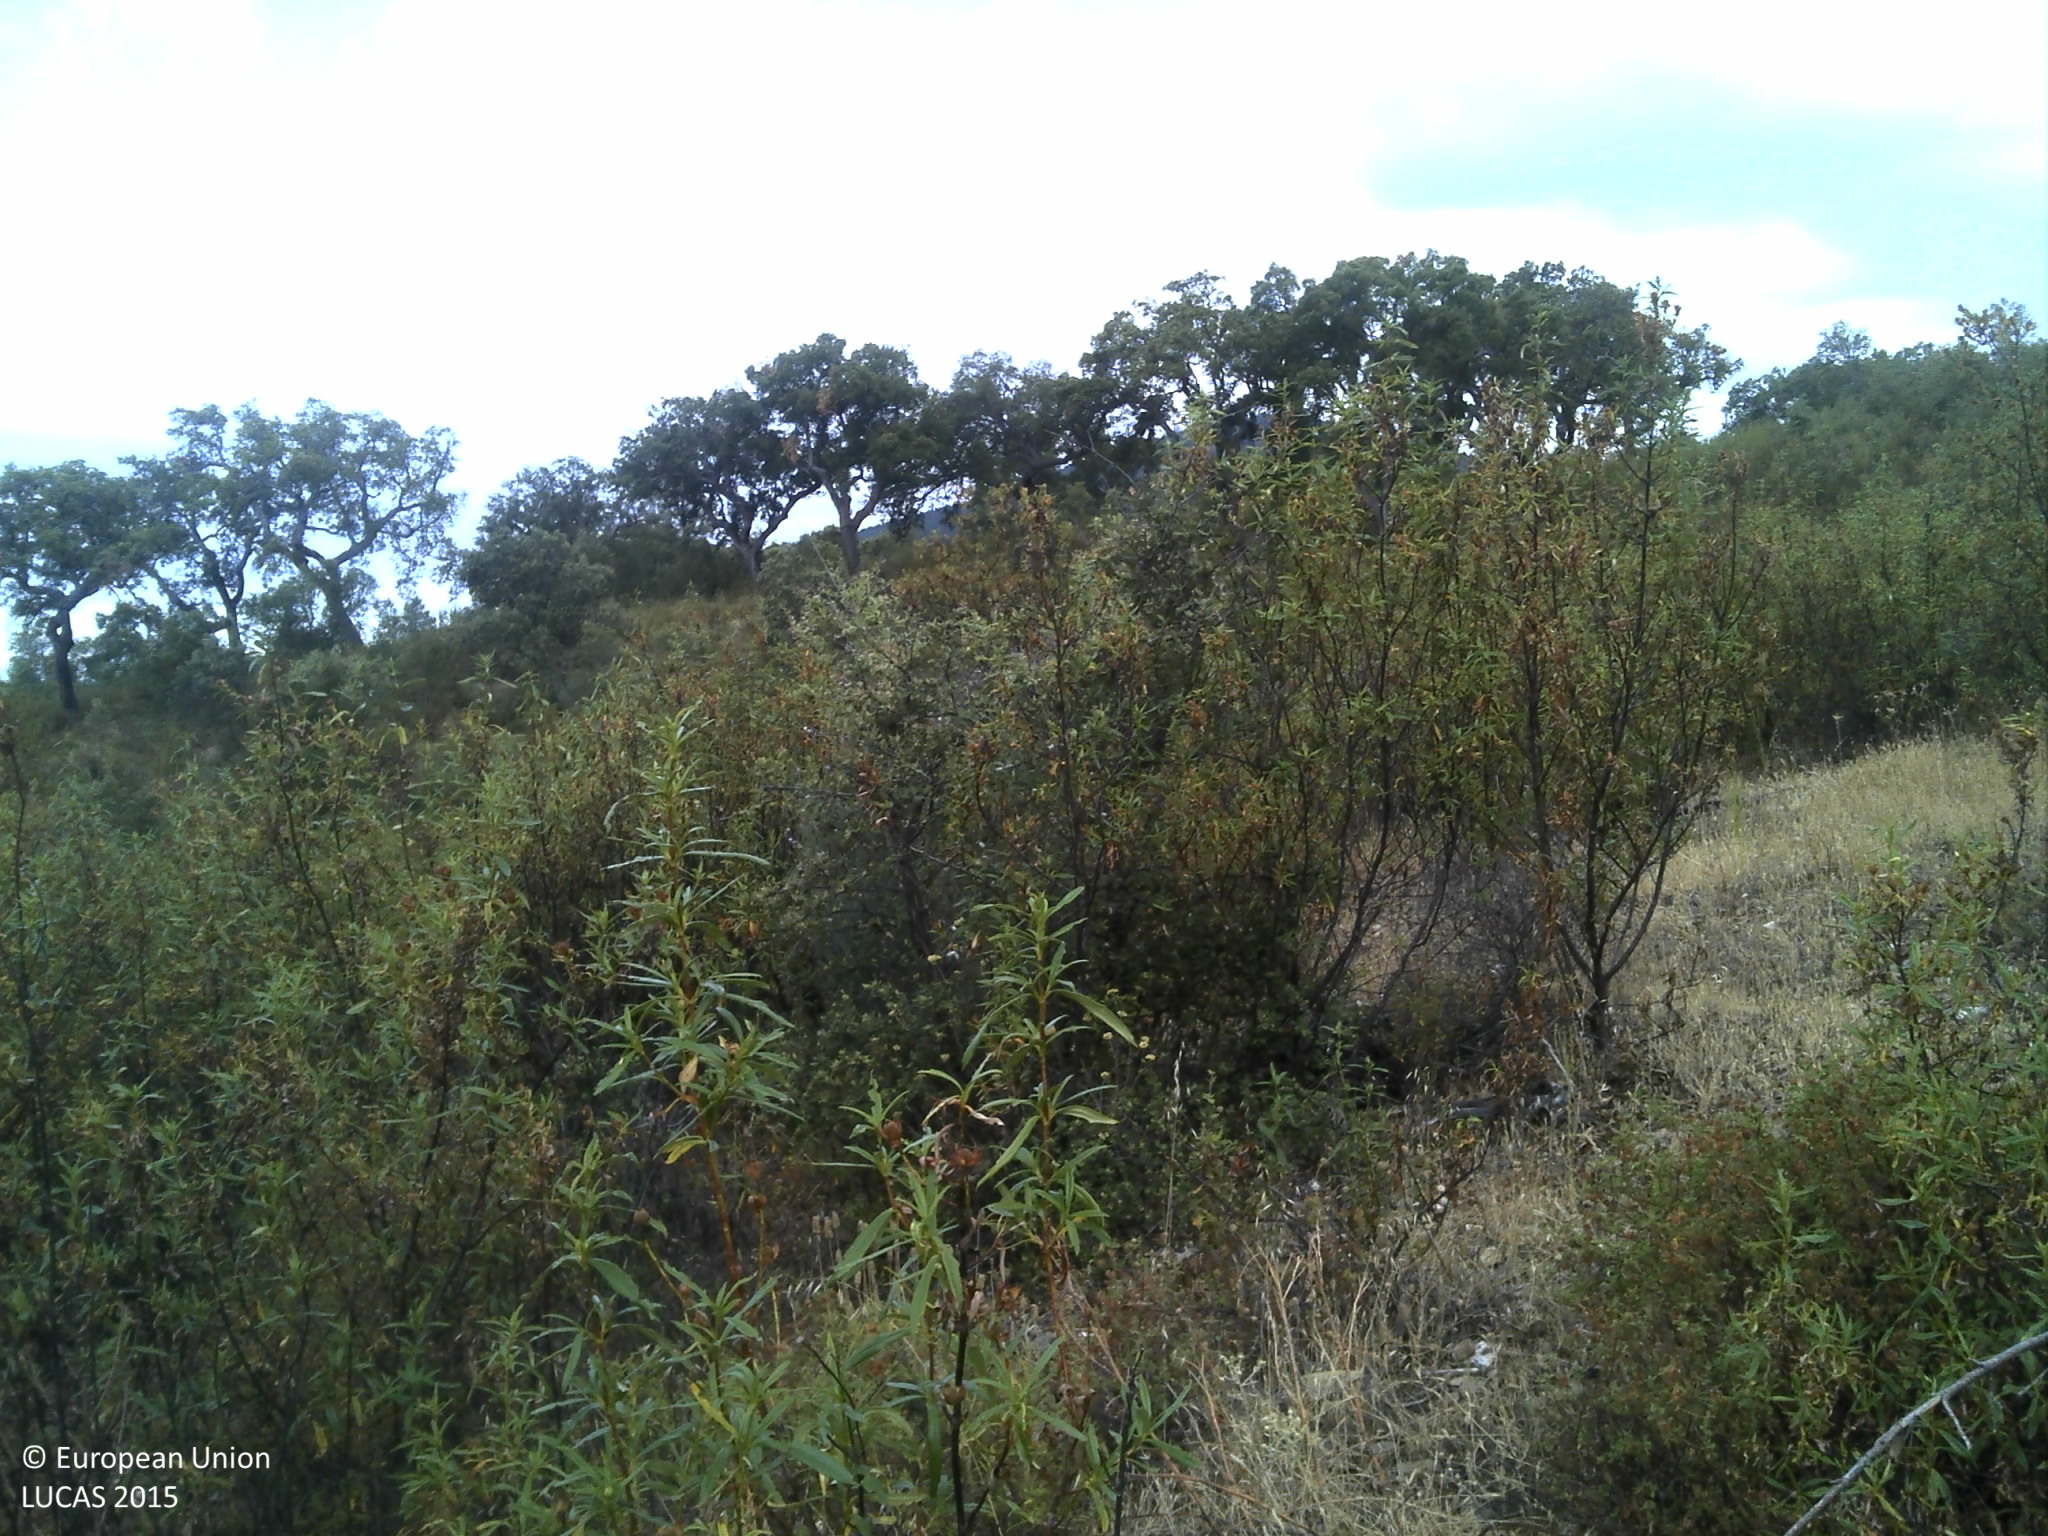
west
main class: Woodland
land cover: Broadleaved woodland
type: broadleaved evergreen forest
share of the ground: 25 - 50 %
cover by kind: broadleaved forest trees 40 %, shrubs 40 %, herbaceous plants 10 %, unconsolidated bare surface 5 %
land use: Forestry
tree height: > 5 m
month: June
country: PT
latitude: 40.1904
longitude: -7.2125
